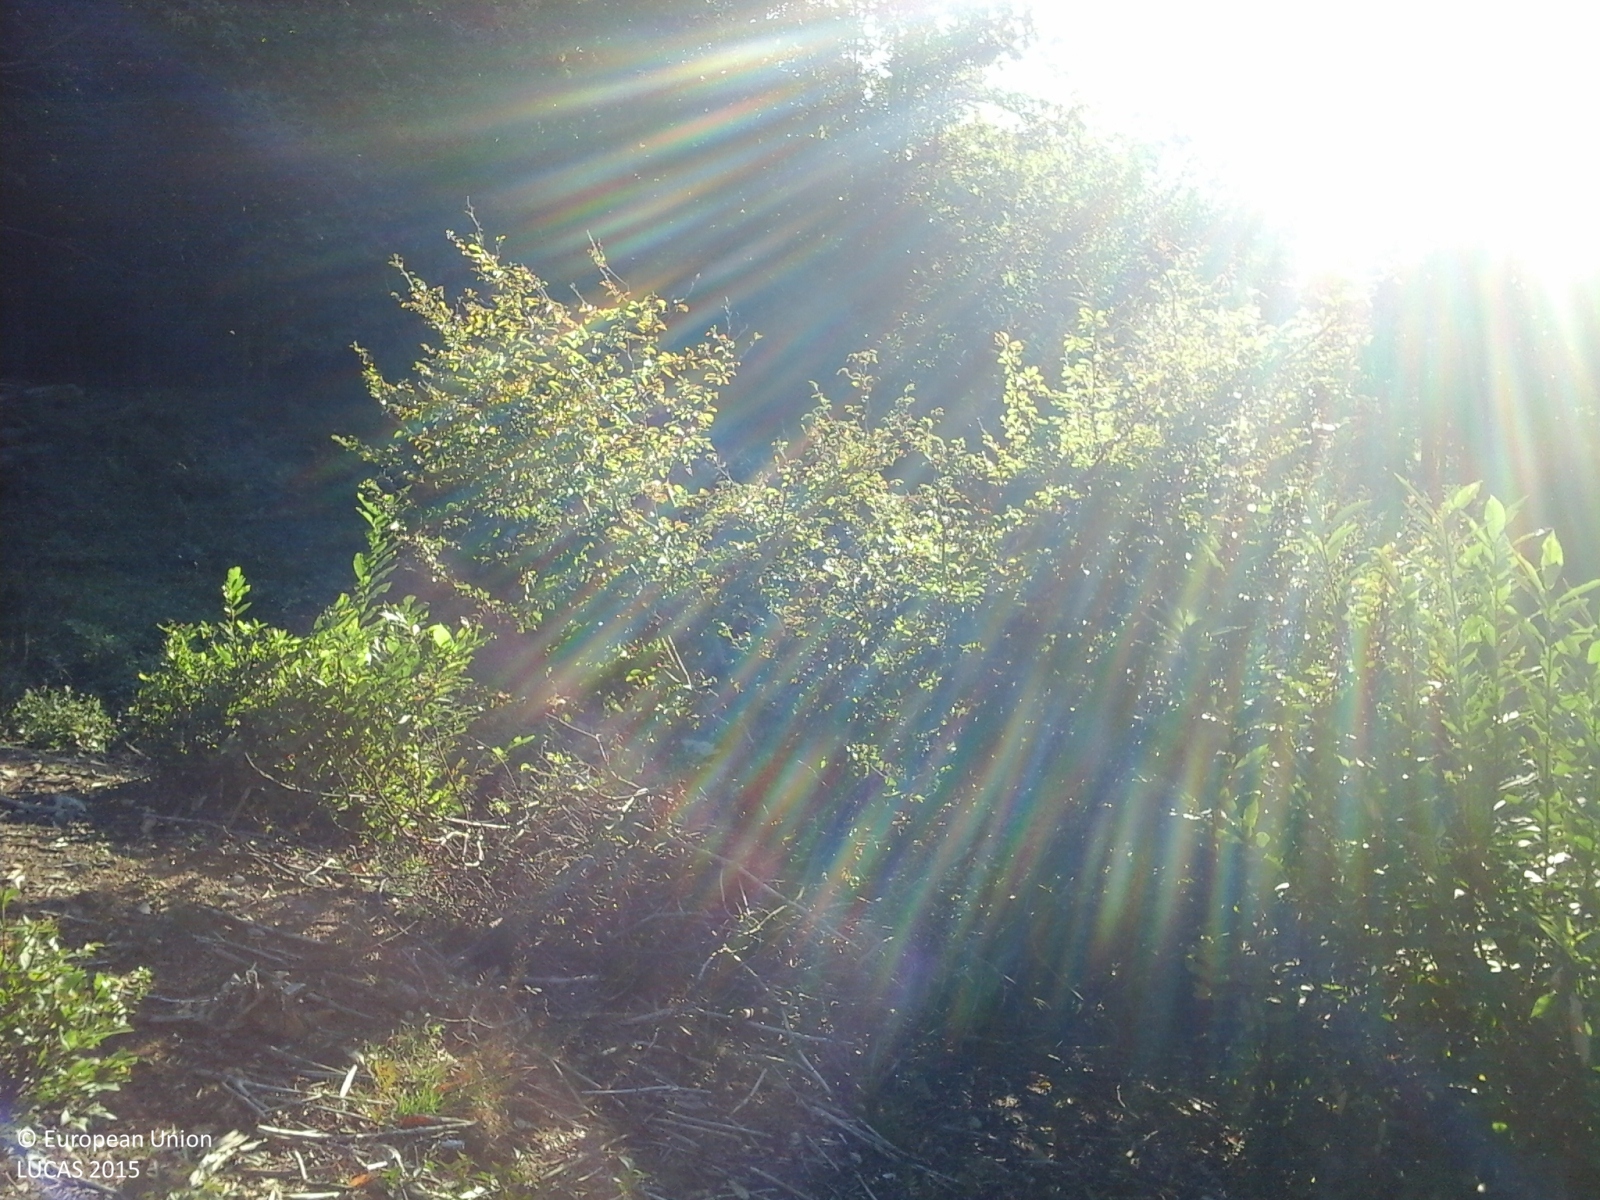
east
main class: Woodland
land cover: Broadleaved woodland
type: thermophilous deciduous forest
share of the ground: > 75 %
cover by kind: broadleaved forest trees 60 %, herbaceous plants 40 %
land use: Forestry
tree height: > 5 m
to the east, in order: Broadleaved woodland; Grassland with sparse tree/shrub cover; Paved roads, cycling and walking lanes; Broadleaved woodland; Grassland without tree/shrub cover; Pine dominated coniferous woodland; Paved roads, cycling and walking lanes; Pine dominated mixed woodland
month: September
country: IT
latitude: 44.5055
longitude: 8.7575
